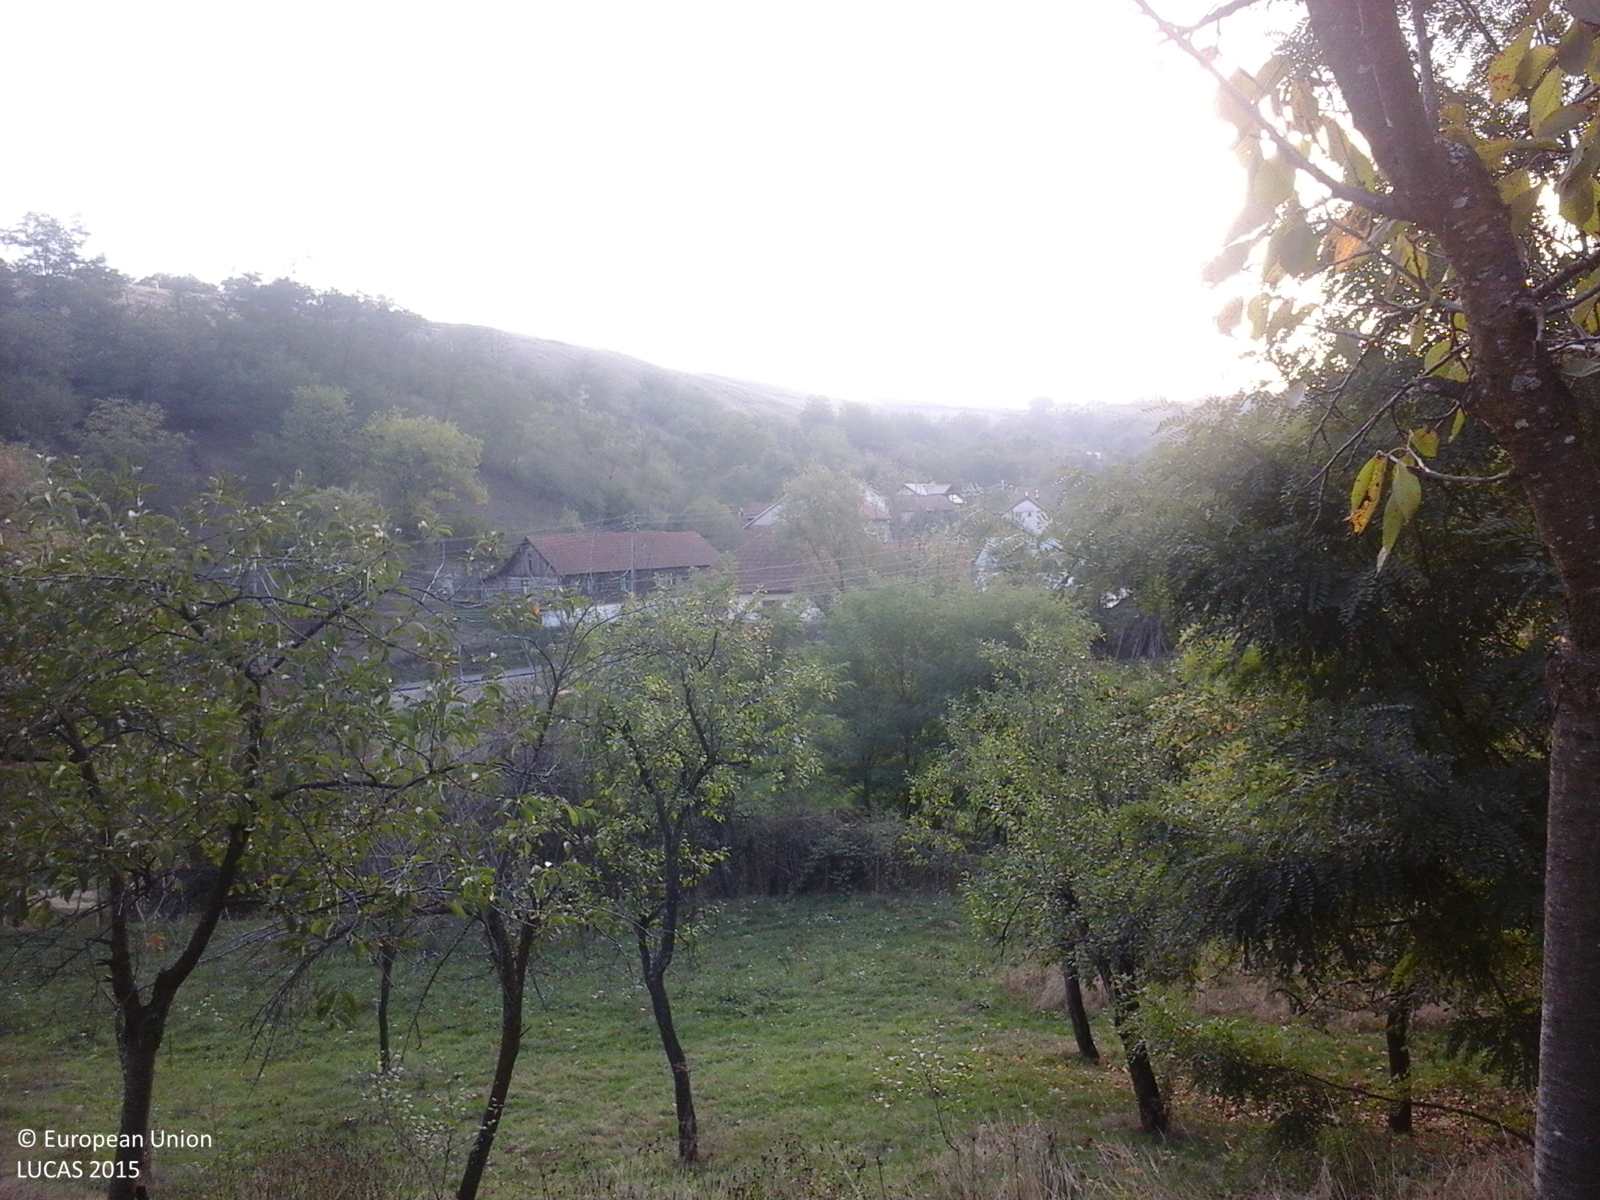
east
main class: Cropland
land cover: Other fruit trees and berries
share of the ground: 25 - 50 %
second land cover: Grassland without tree/shrub cover
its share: > 75 %
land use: Agriculture (excluding fallow land and kitchen gardens)
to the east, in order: Other fruit trees and berries; Grassland without tree/shrub cover; Fences; Grassland without tree/shrub cover; Tracks; Shruby margins; Rivers and streams; Electric lines; Grassland without tree/shrub cover; Artificial constructions in urban areas; Other fruit trees and berries
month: September
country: RO
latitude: 45.3457
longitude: 21.9962
